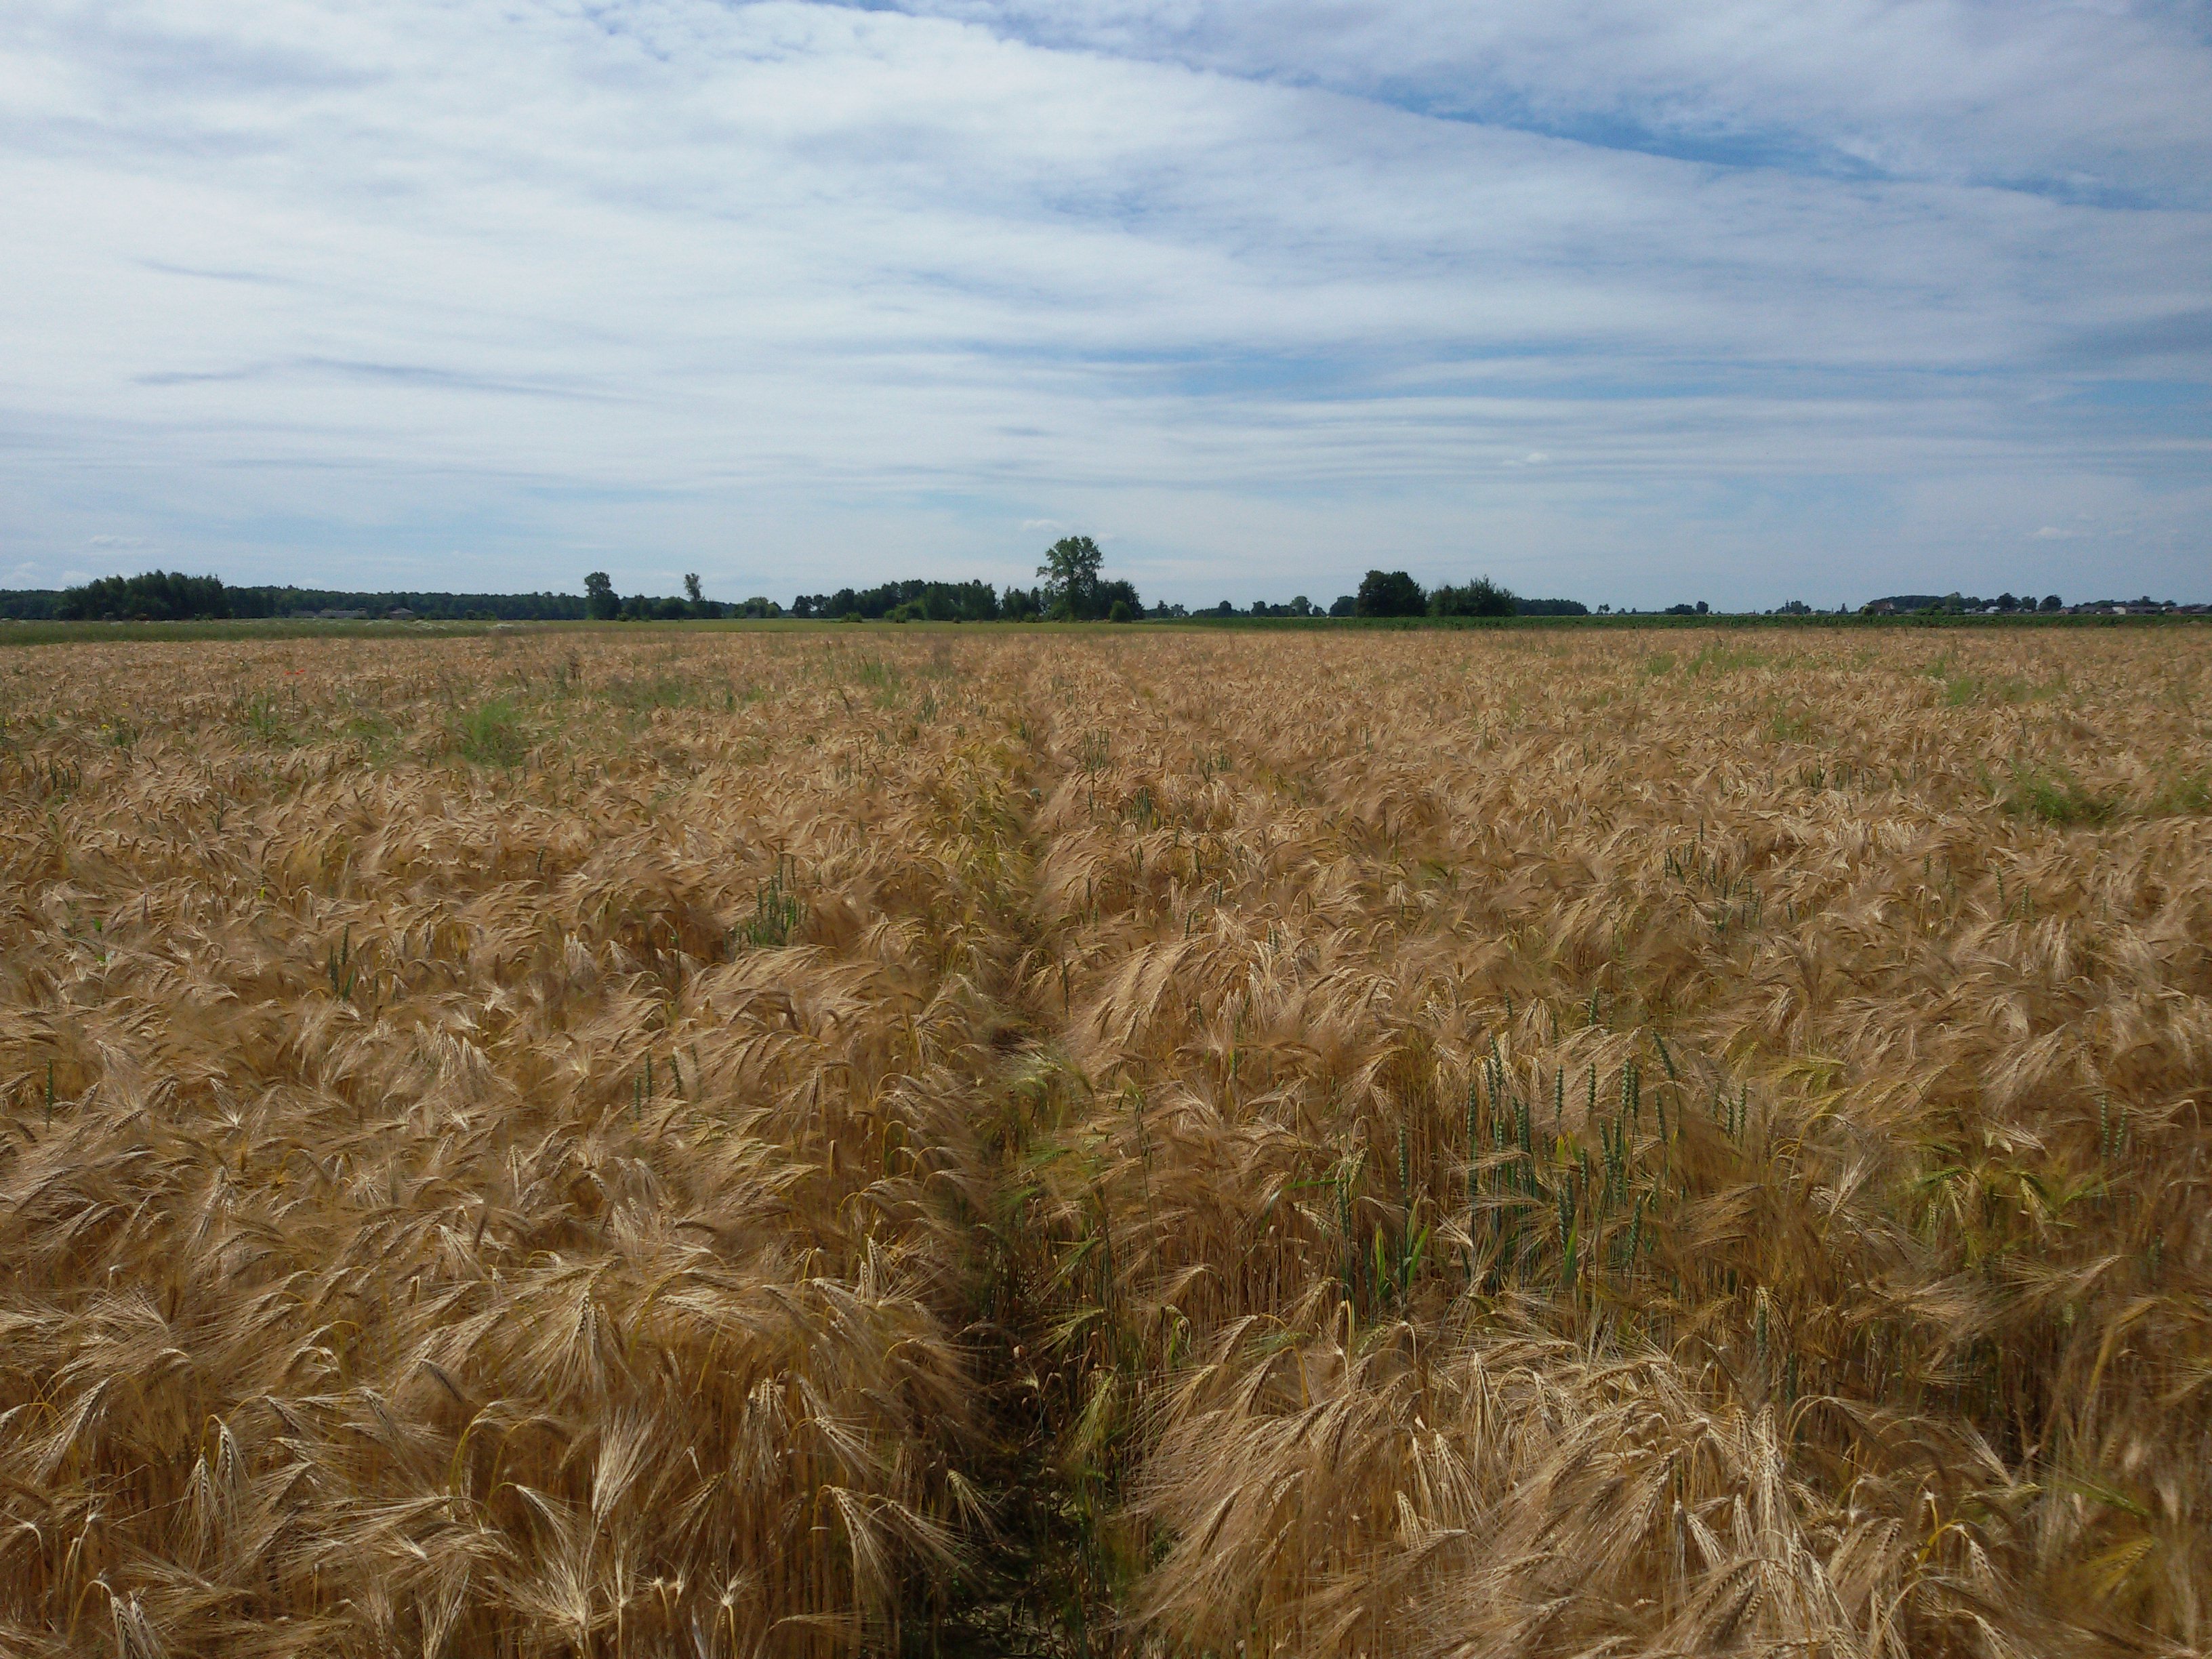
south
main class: Cropland
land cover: Barley
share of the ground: > 75 %
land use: Agriculture (excluding fallow land and kitchen gardens)
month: June
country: PL
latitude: 51.7278
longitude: 23.0335
